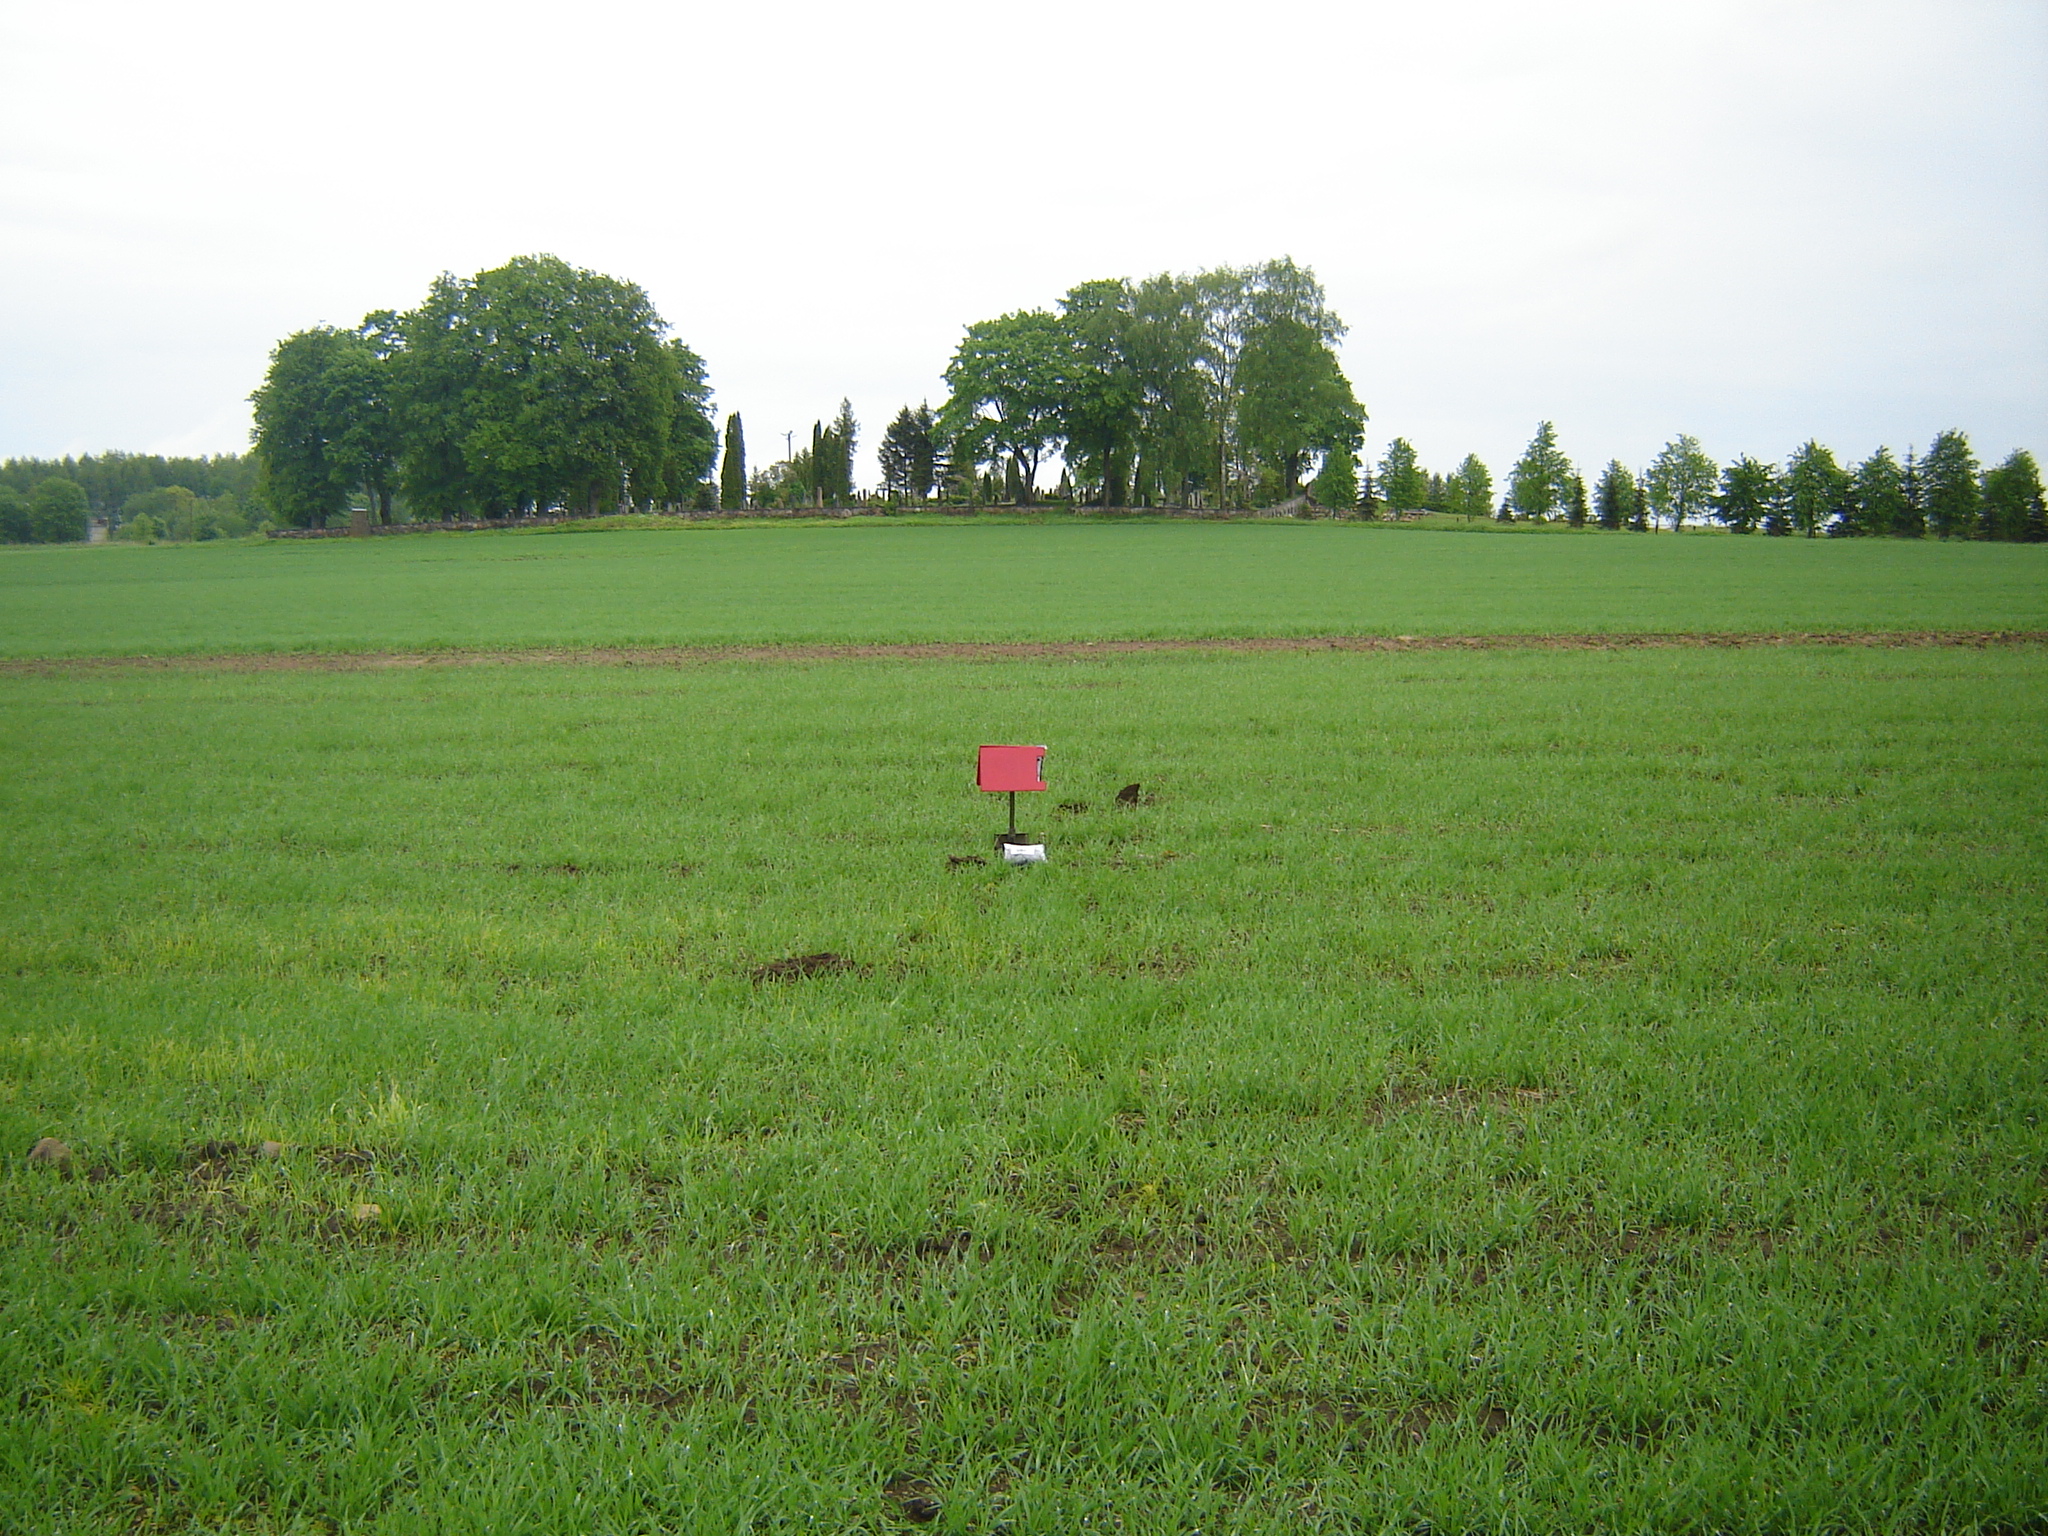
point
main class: Cropland
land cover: Common wheat
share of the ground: 50 - 75 %
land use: Agriculture (excluding fallow land and kitchen gardens)
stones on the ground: < 10 %
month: May
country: LT
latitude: 55.8809
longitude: 25.1894
